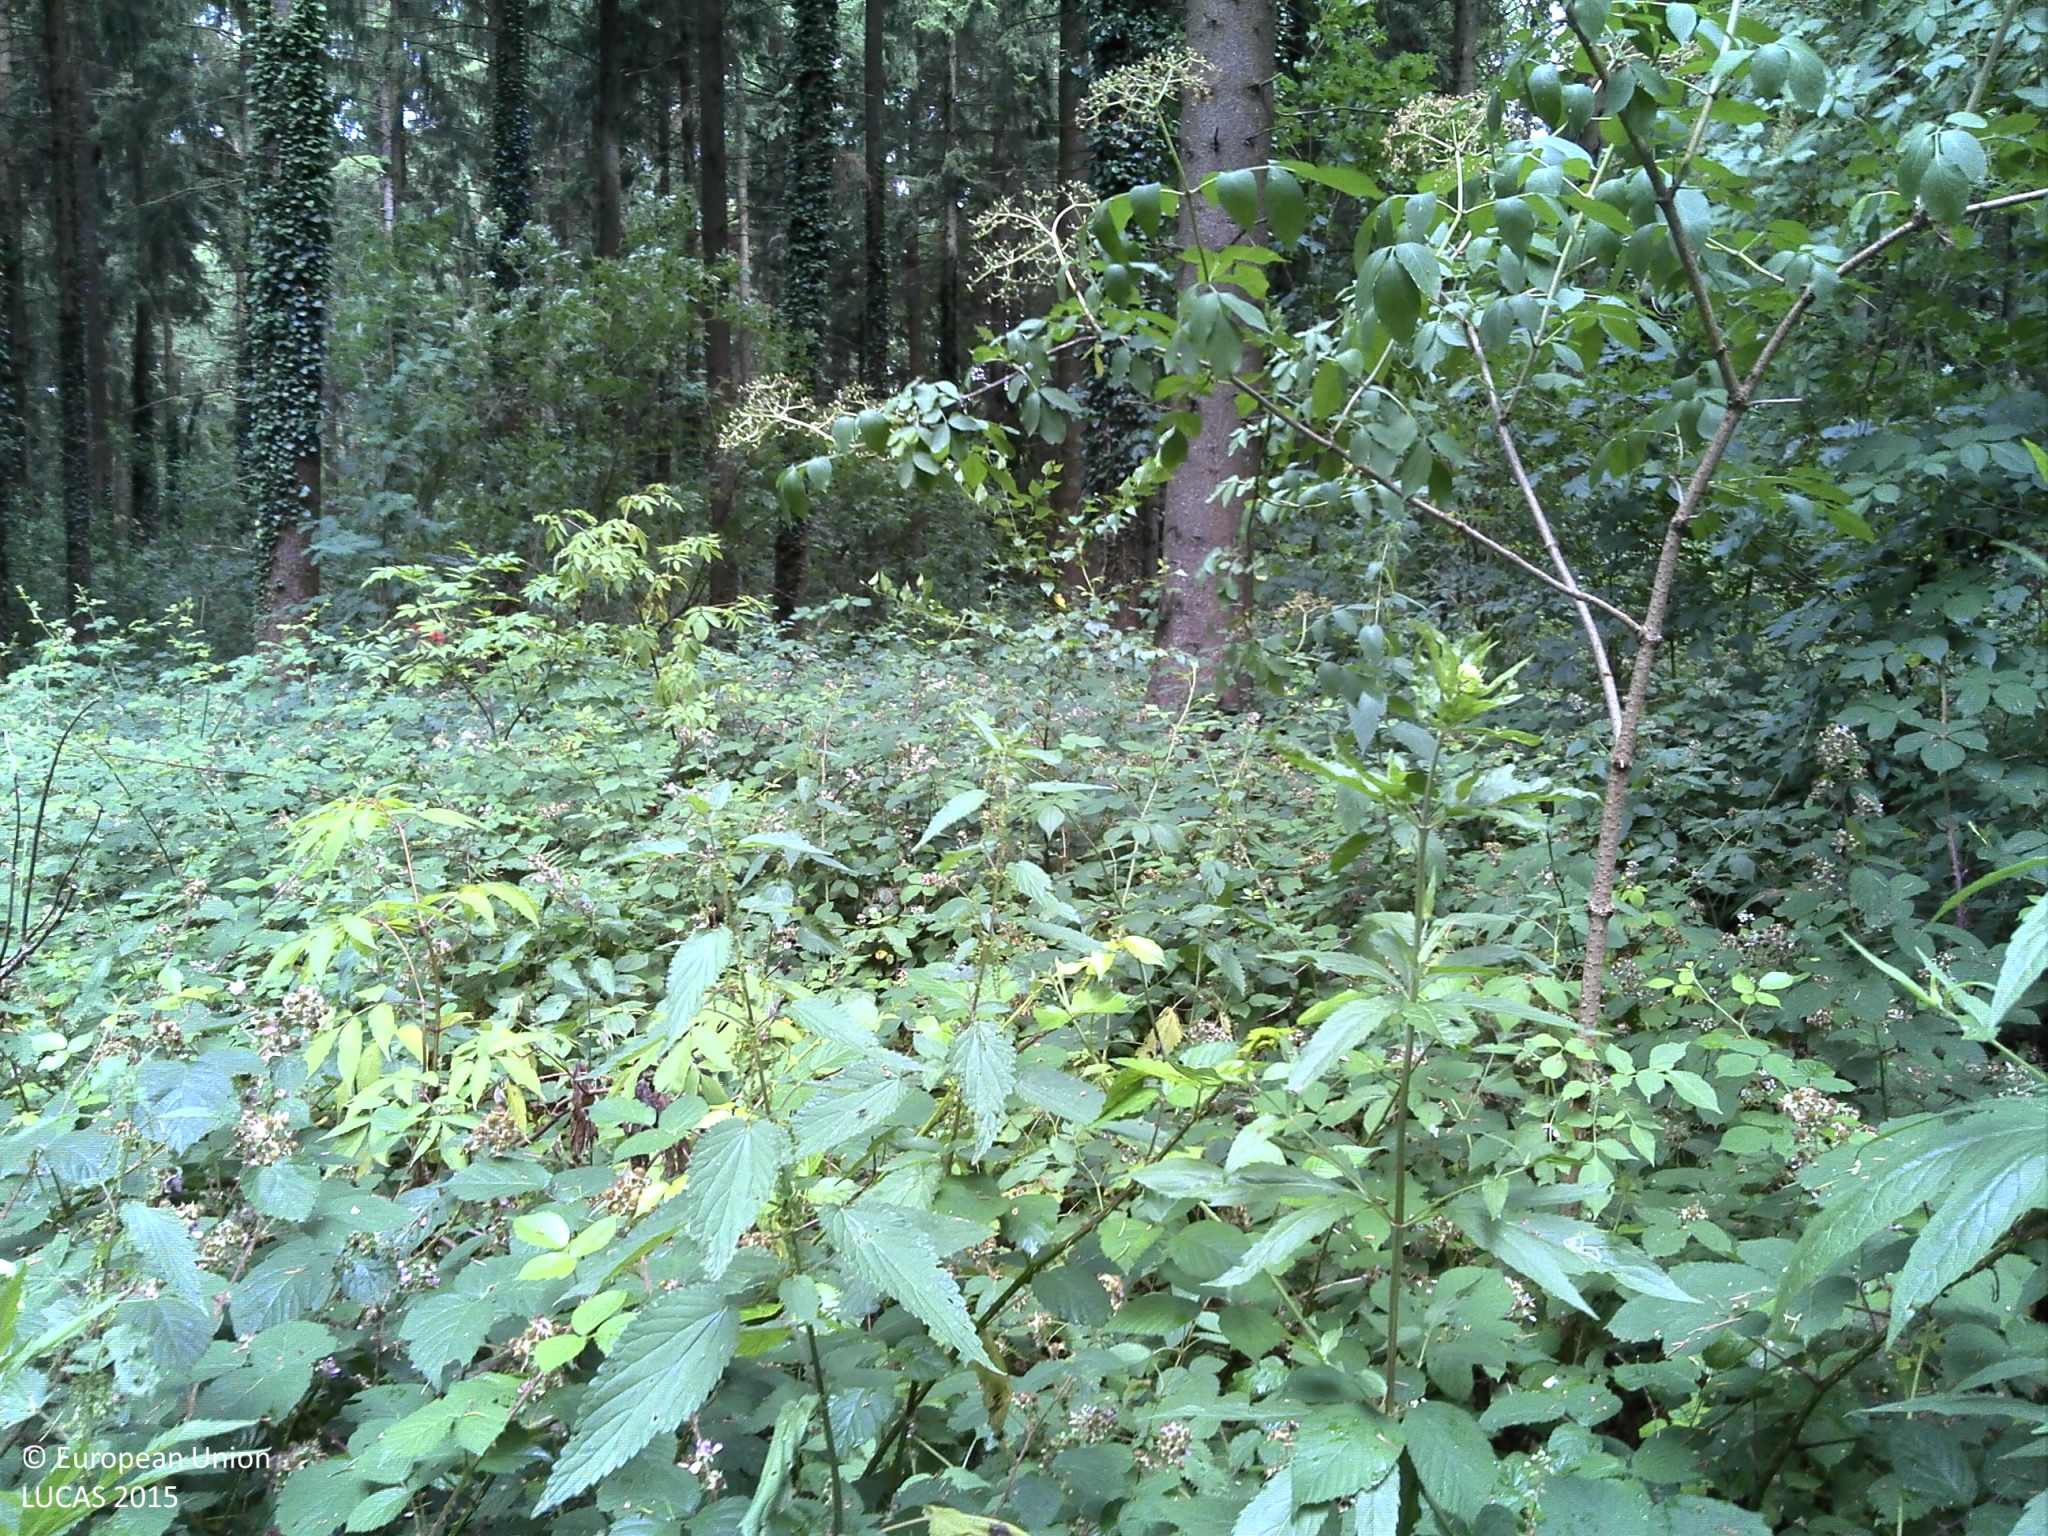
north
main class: Woodland
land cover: Spruce dominated coniferous woodland
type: exotic forest
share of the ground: > 75 %
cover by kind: coniferous forest trees 75 %, herbaceous plants 20 %, broadleaved forest trees 5 %
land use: Forestry
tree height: > 5 m
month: July
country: LU
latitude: 49.4493
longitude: 6.0406
